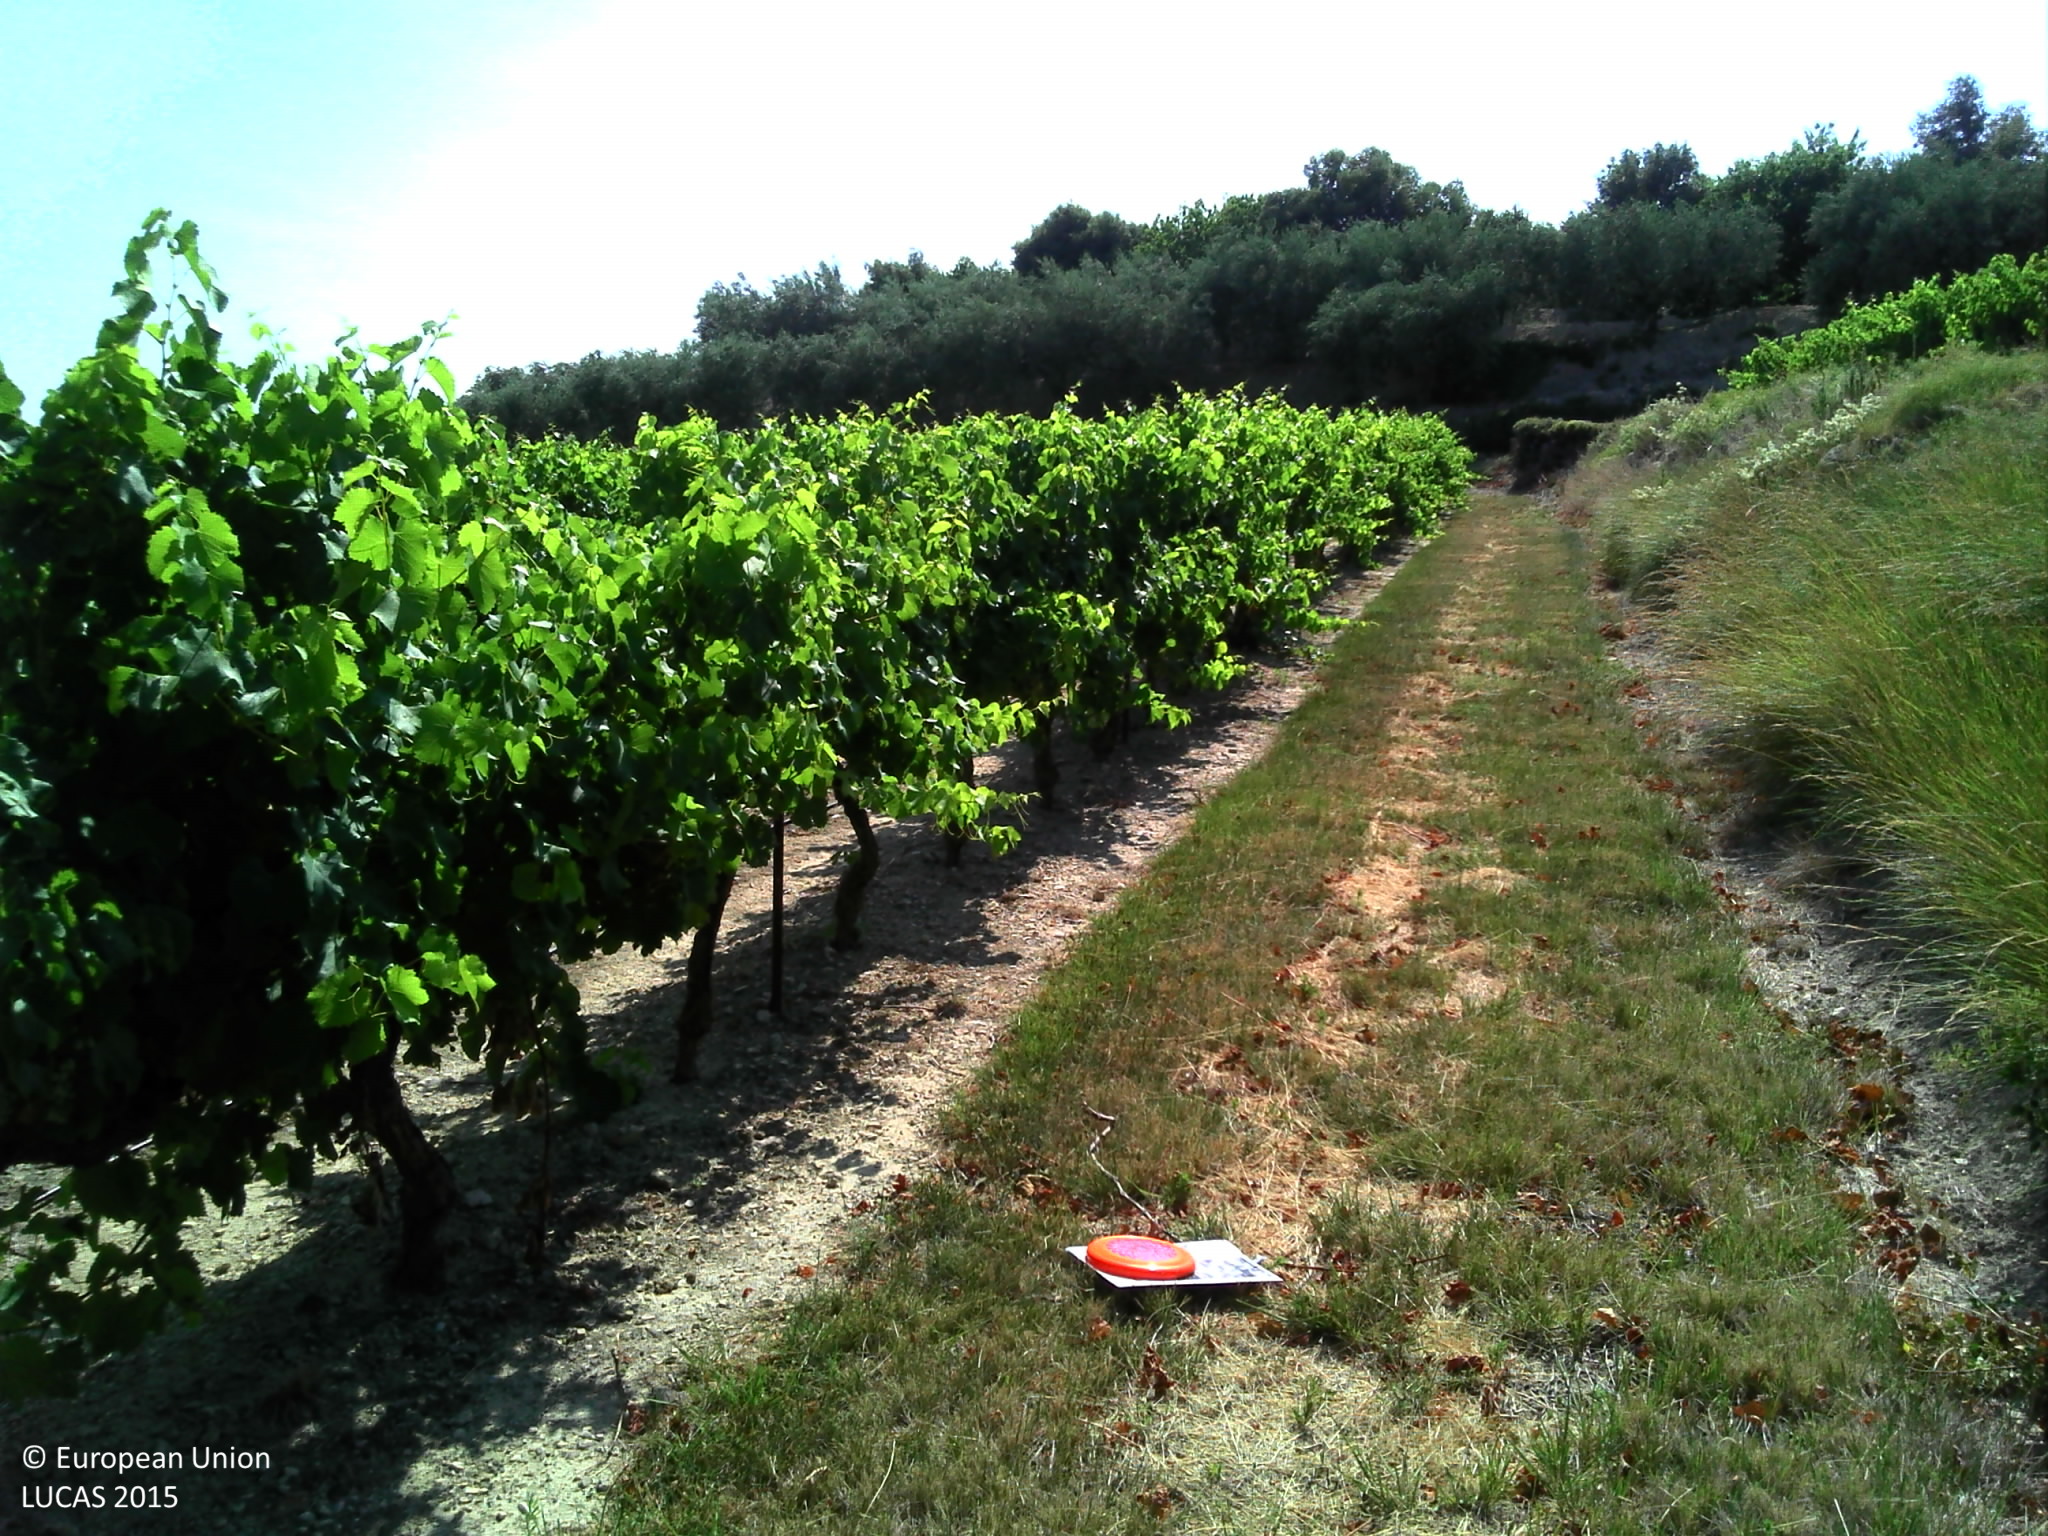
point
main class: Grassland
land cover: Grassland without tree/shrub cover
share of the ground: > 75 %
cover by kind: herbaceous plants 80 %, unconsolidated bare surface 20 %
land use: Agriculture (excluding fallow land and kitchen gardens)
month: July
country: FR
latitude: 44.1251
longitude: 5.0717
